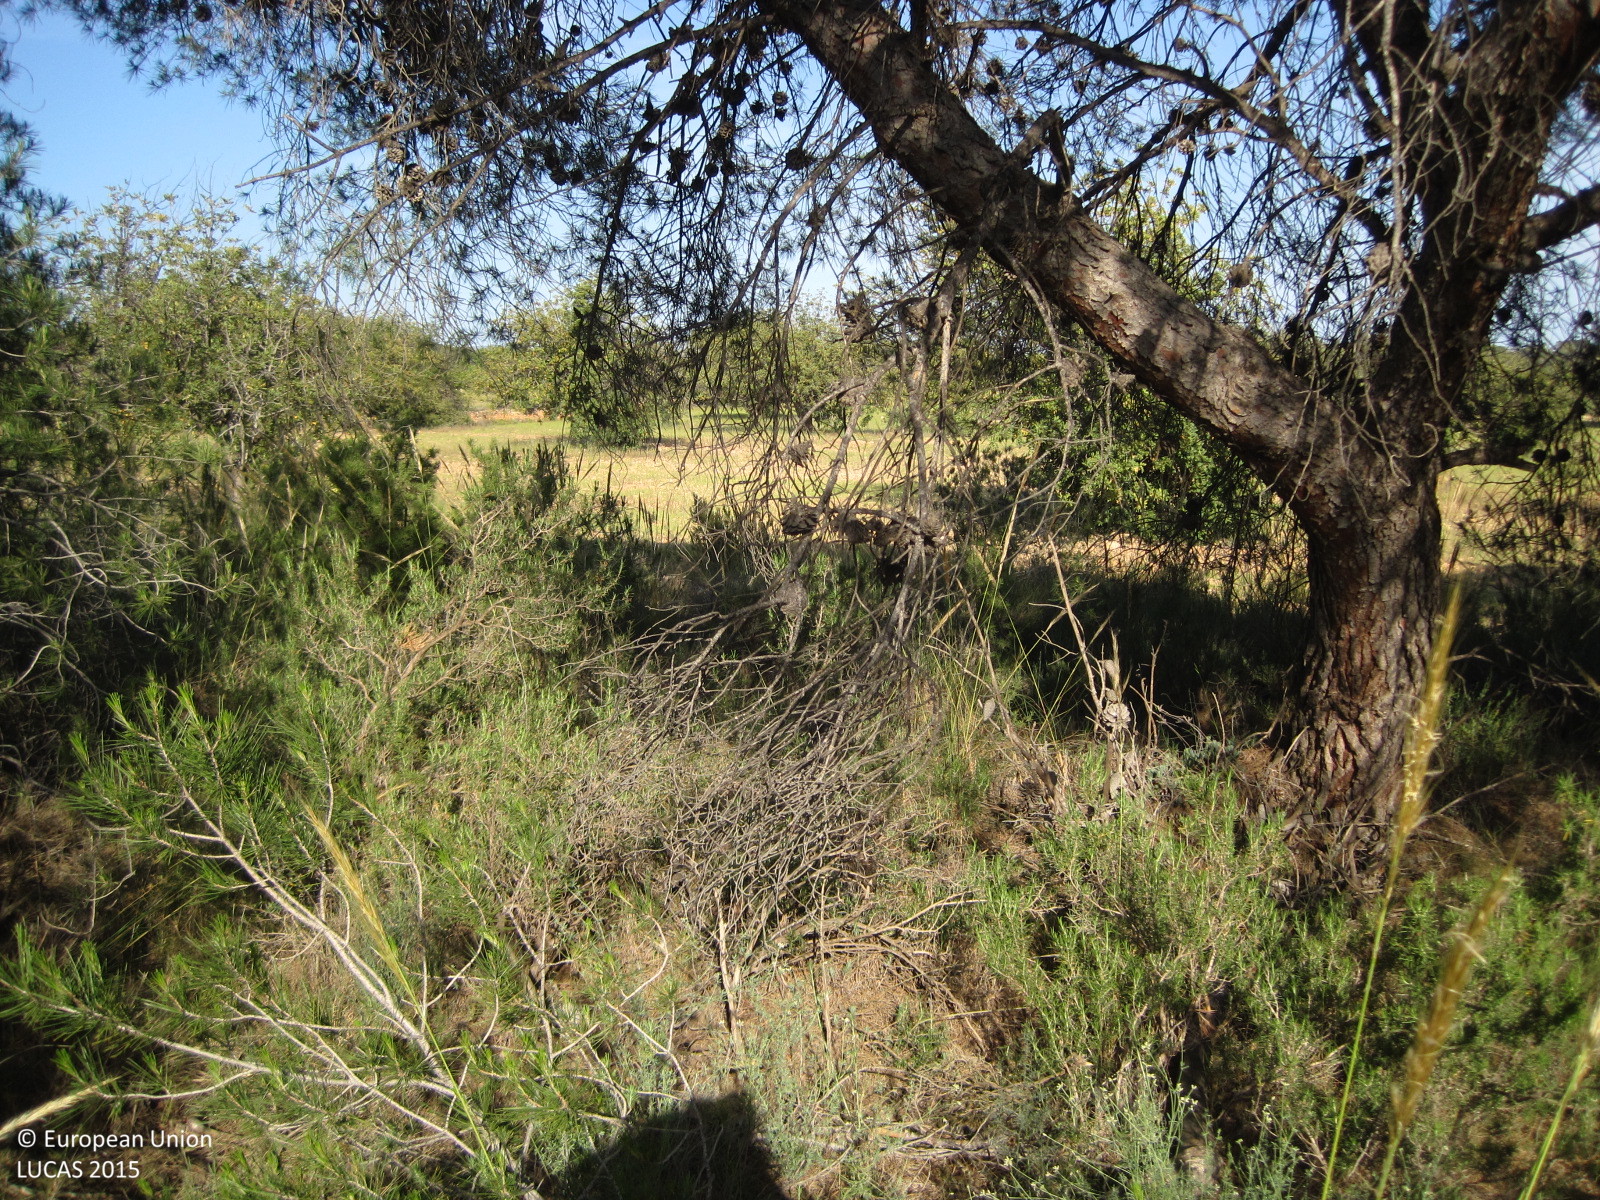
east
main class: Woodland
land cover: Pine dominated coniferous woodland
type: coniferous forest of the mediterranean region
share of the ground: > 75 %
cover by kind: shrubs 55 %, coniferous forest trees 25 %, herbaceous plants 10 %, consolidated bare surface 10 %
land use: Semi-natural and natural areas not in use
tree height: > 5 m
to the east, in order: Pine dominated coniferous woodland; Permanent industrial crops; Dry stone walls; Shruby margins; Permanent industrial crops; Tracks; Other citrus fruit
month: May
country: ES
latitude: 39.7221
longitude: -0.6525
